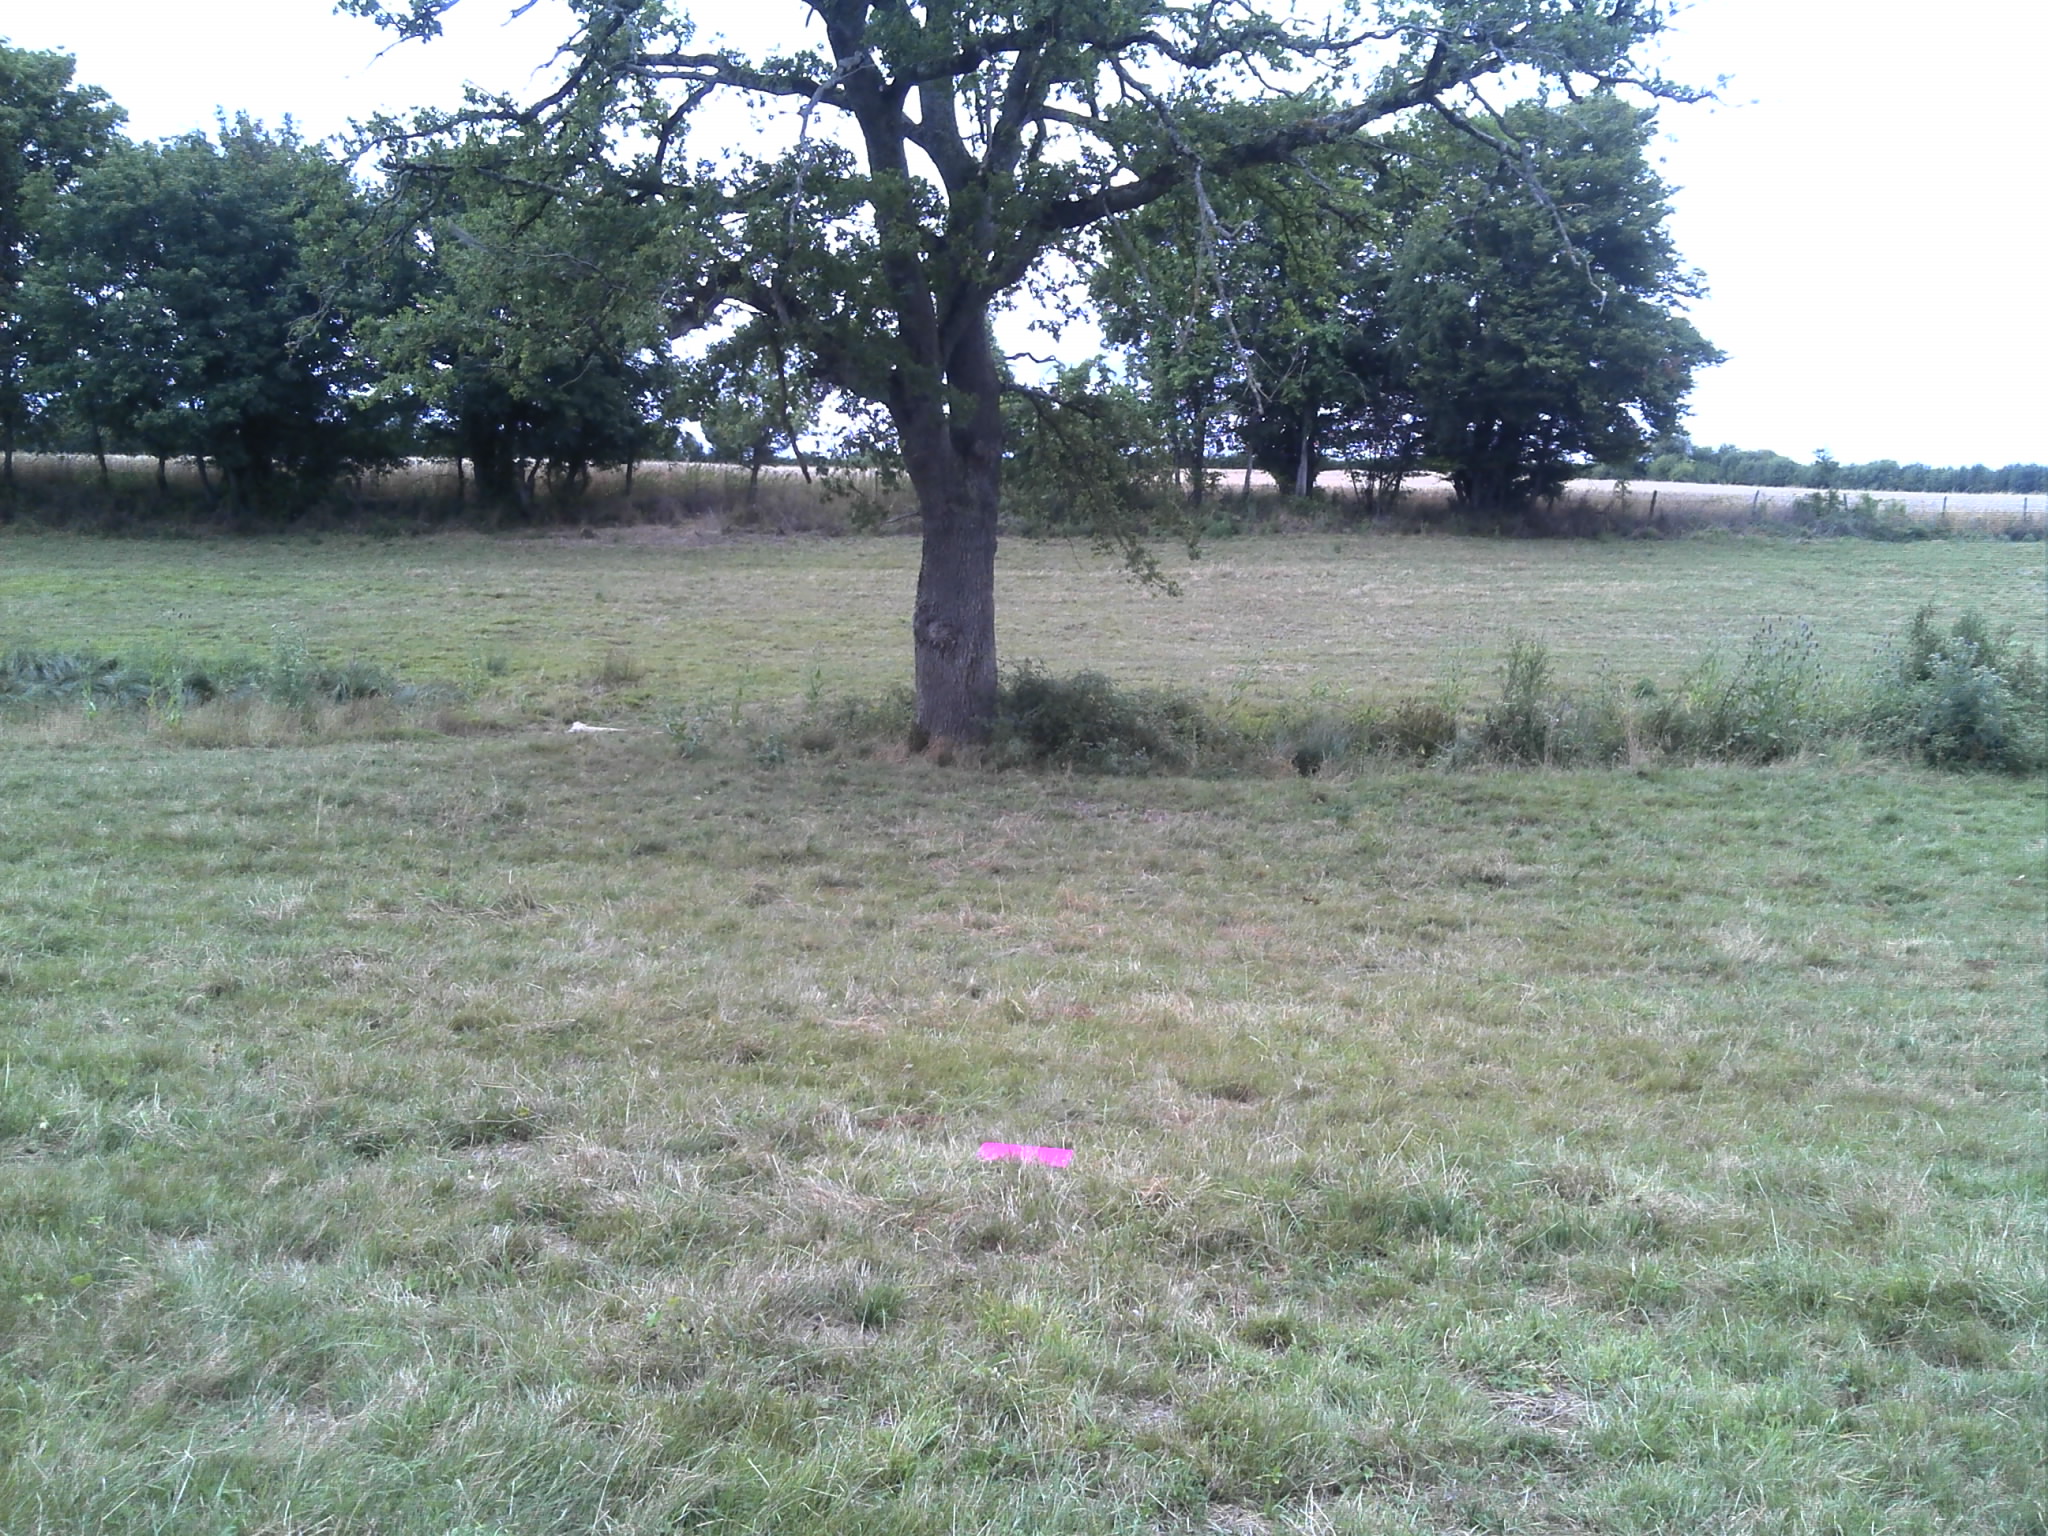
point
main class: Grassland
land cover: Grassland with sparse tree/shrub cover
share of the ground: > 75 %
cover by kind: herbaceous plants 95 %, broadleaved forest trees 5 %
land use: Agriculture (excluding fallow land and kitchen gardens)
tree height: > 5 m
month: July
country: FR
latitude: 46.5217
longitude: 1.5298
